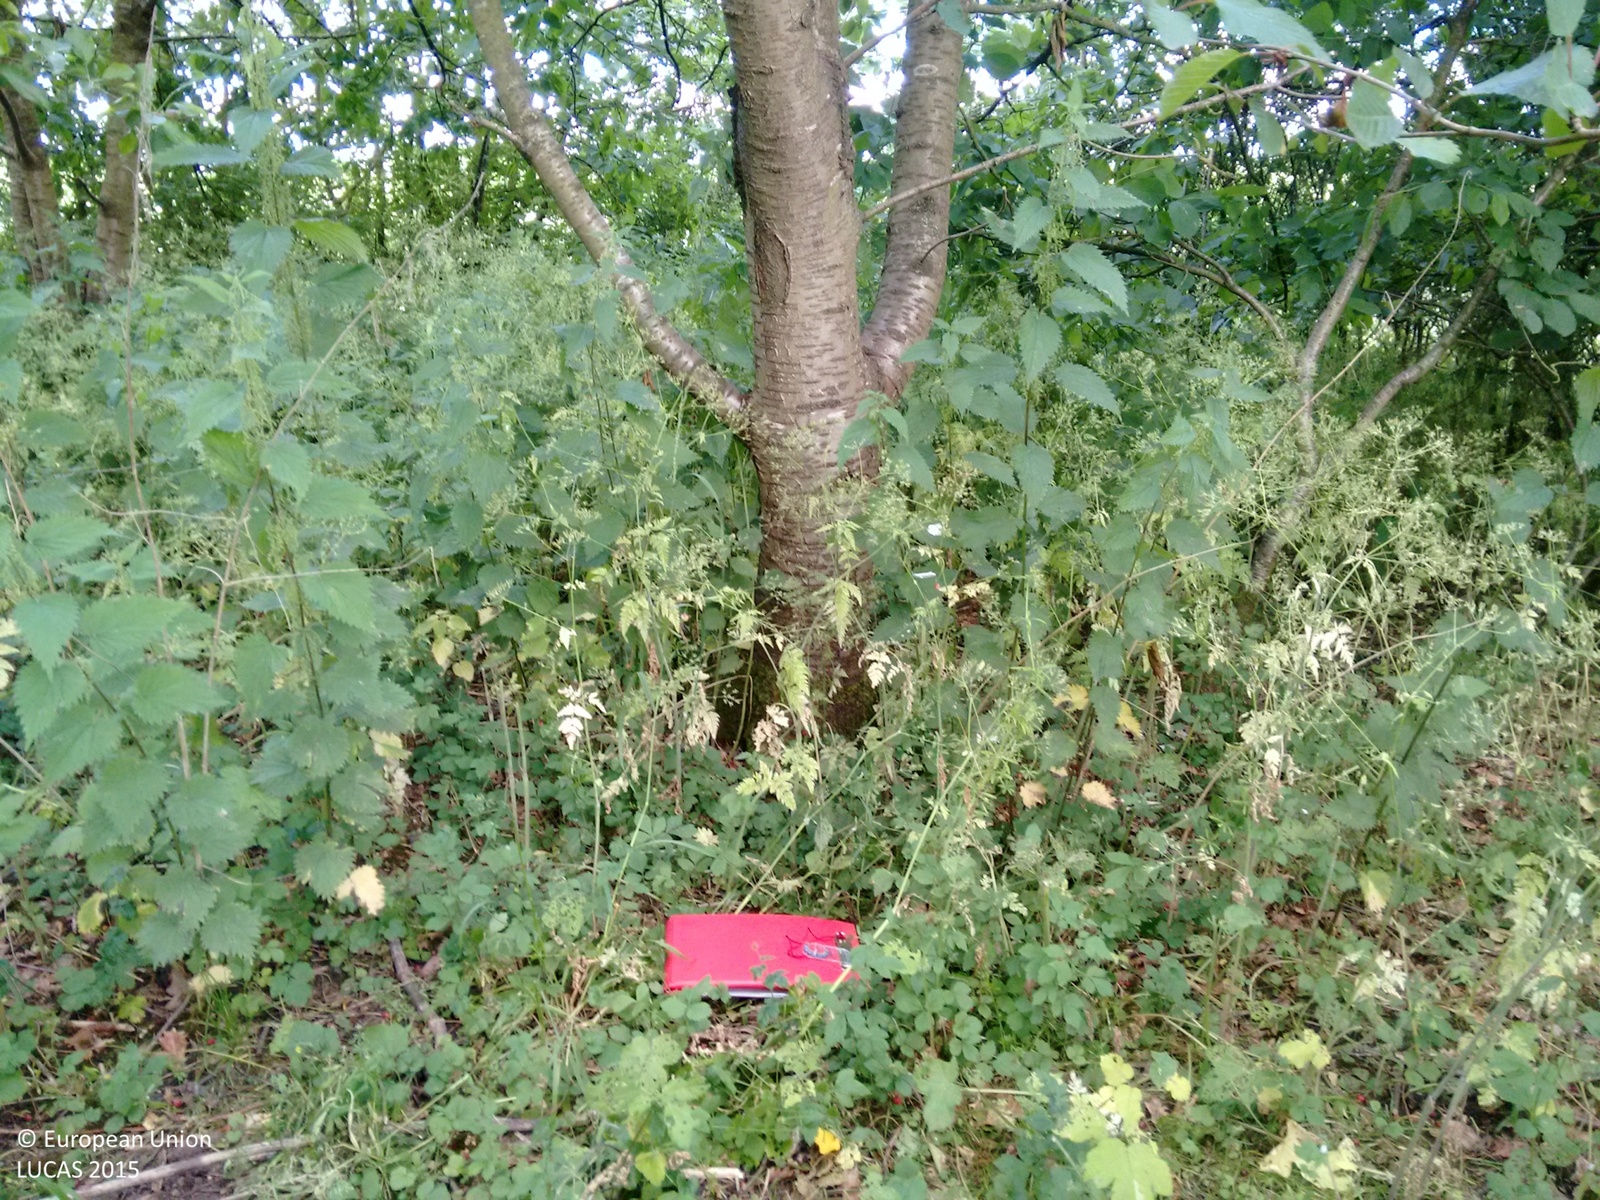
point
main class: Woodland
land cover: Broadleaved woodland
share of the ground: > 75 %
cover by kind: broadleaved forest trees 95 %, shrubs 5 %
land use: Semi-natural and natural areas not in use
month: June
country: GB
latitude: 52.1982
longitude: -1.8633
